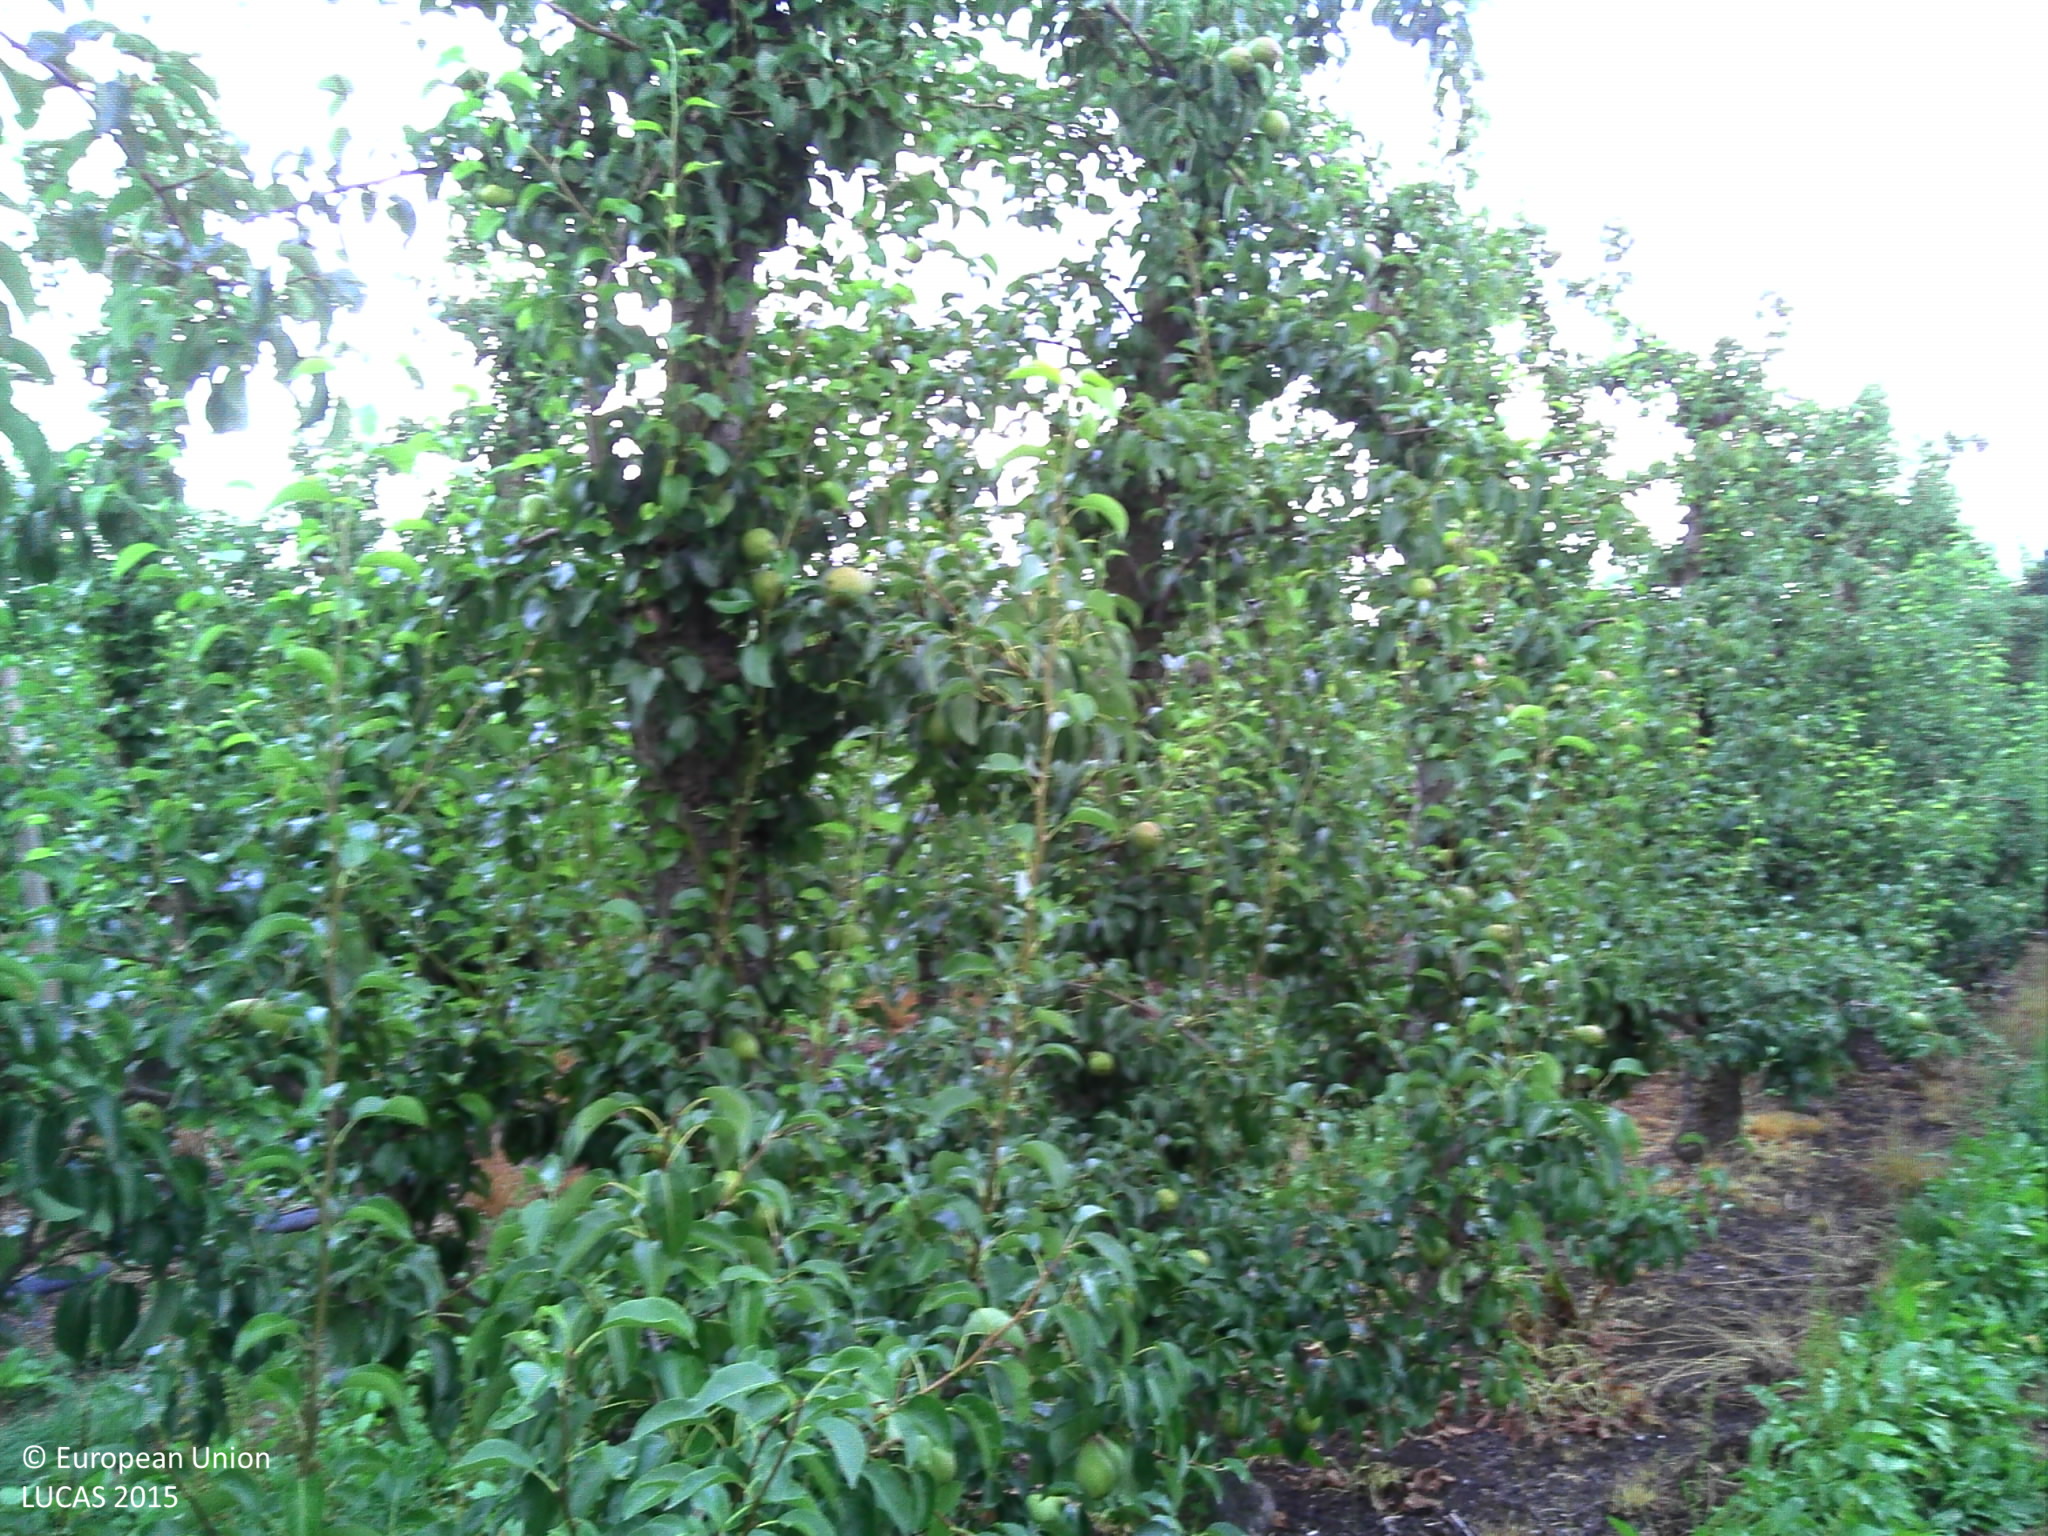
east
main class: Cropland
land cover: Pear fruit
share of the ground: 50 - 75 %
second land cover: Spontaneously vegetated surfaces
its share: 25 - 50 %
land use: Agriculture (excluding fallow land and kitchen gardens)
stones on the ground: < 10 %
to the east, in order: Pear fruit; Spontaneously vegetated surfaces; Rivers and streams; Pear fruit; Tracks; Pear fruit; Tracks; Pear fruit
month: July
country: BE
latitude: 50.8737
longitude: 5.1515
